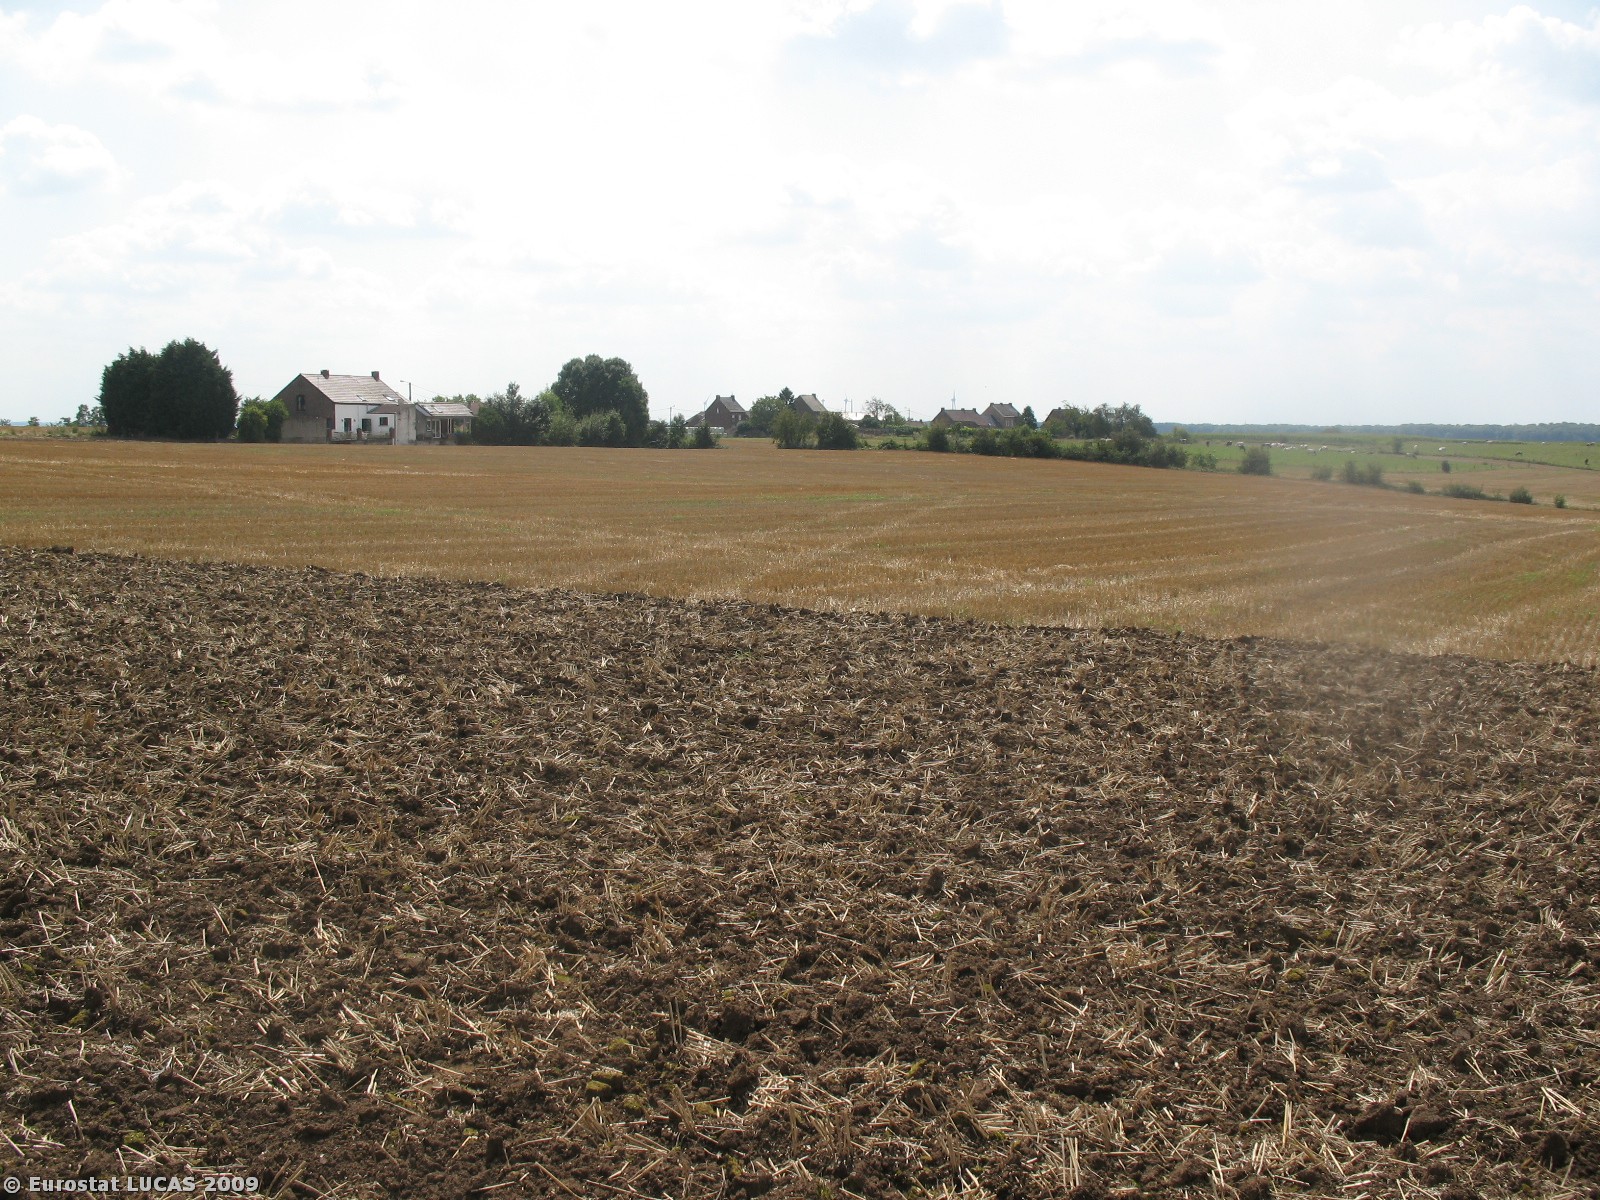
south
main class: Cropland
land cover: Common wheat
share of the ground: > 75 %
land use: Agriculture (excluding fallow land and kitchen gardens)
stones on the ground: < 10 %
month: August
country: BE
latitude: 50.4817
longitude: 4.0896
